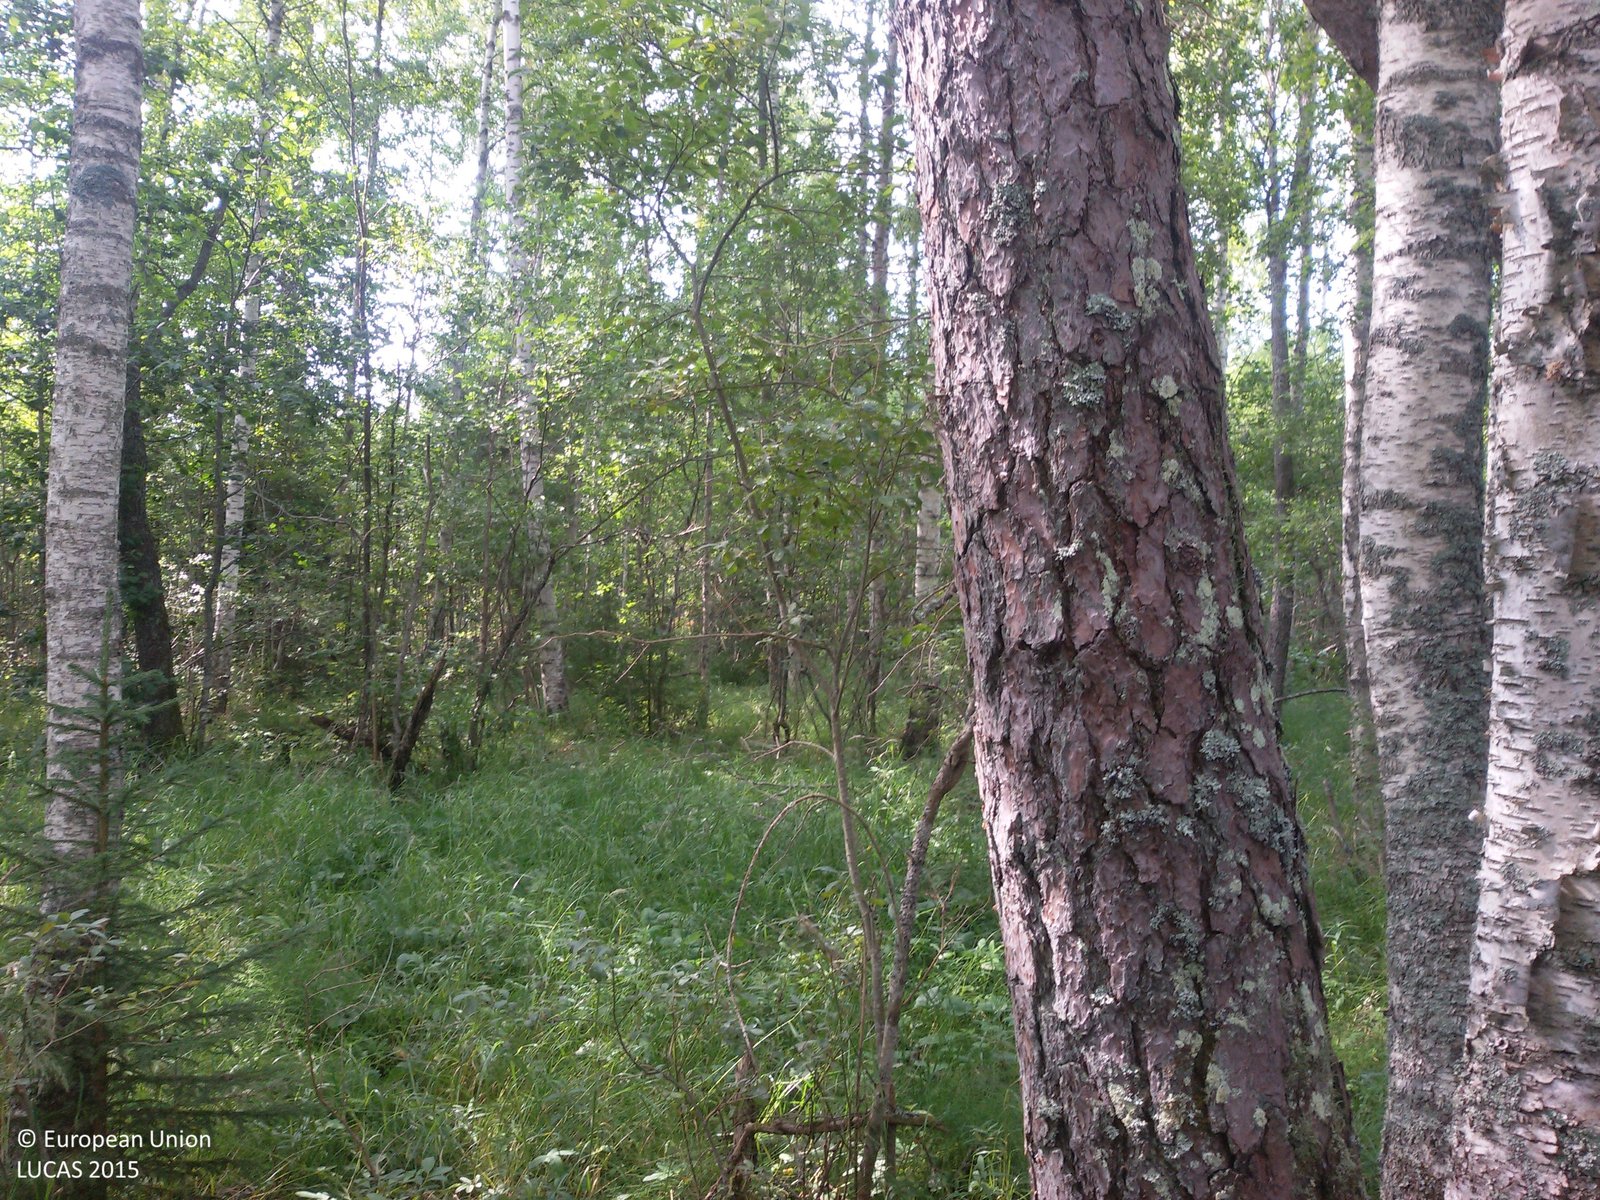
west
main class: Woodland
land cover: Pine dominated mixed woodland
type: hemiboreal forest and nemoral coniferous forest and mixed broadleaved-coniferous forest
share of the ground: > 75 %
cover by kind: broadleaved forest trees 60 %, coniferous forest trees 25 %, herbaceous plants 10 %, lichens and mosses 5 %
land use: Semi-natural and natural areas not in use
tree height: > 5 m
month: August
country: SE
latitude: 60.4767
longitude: 16.6291
